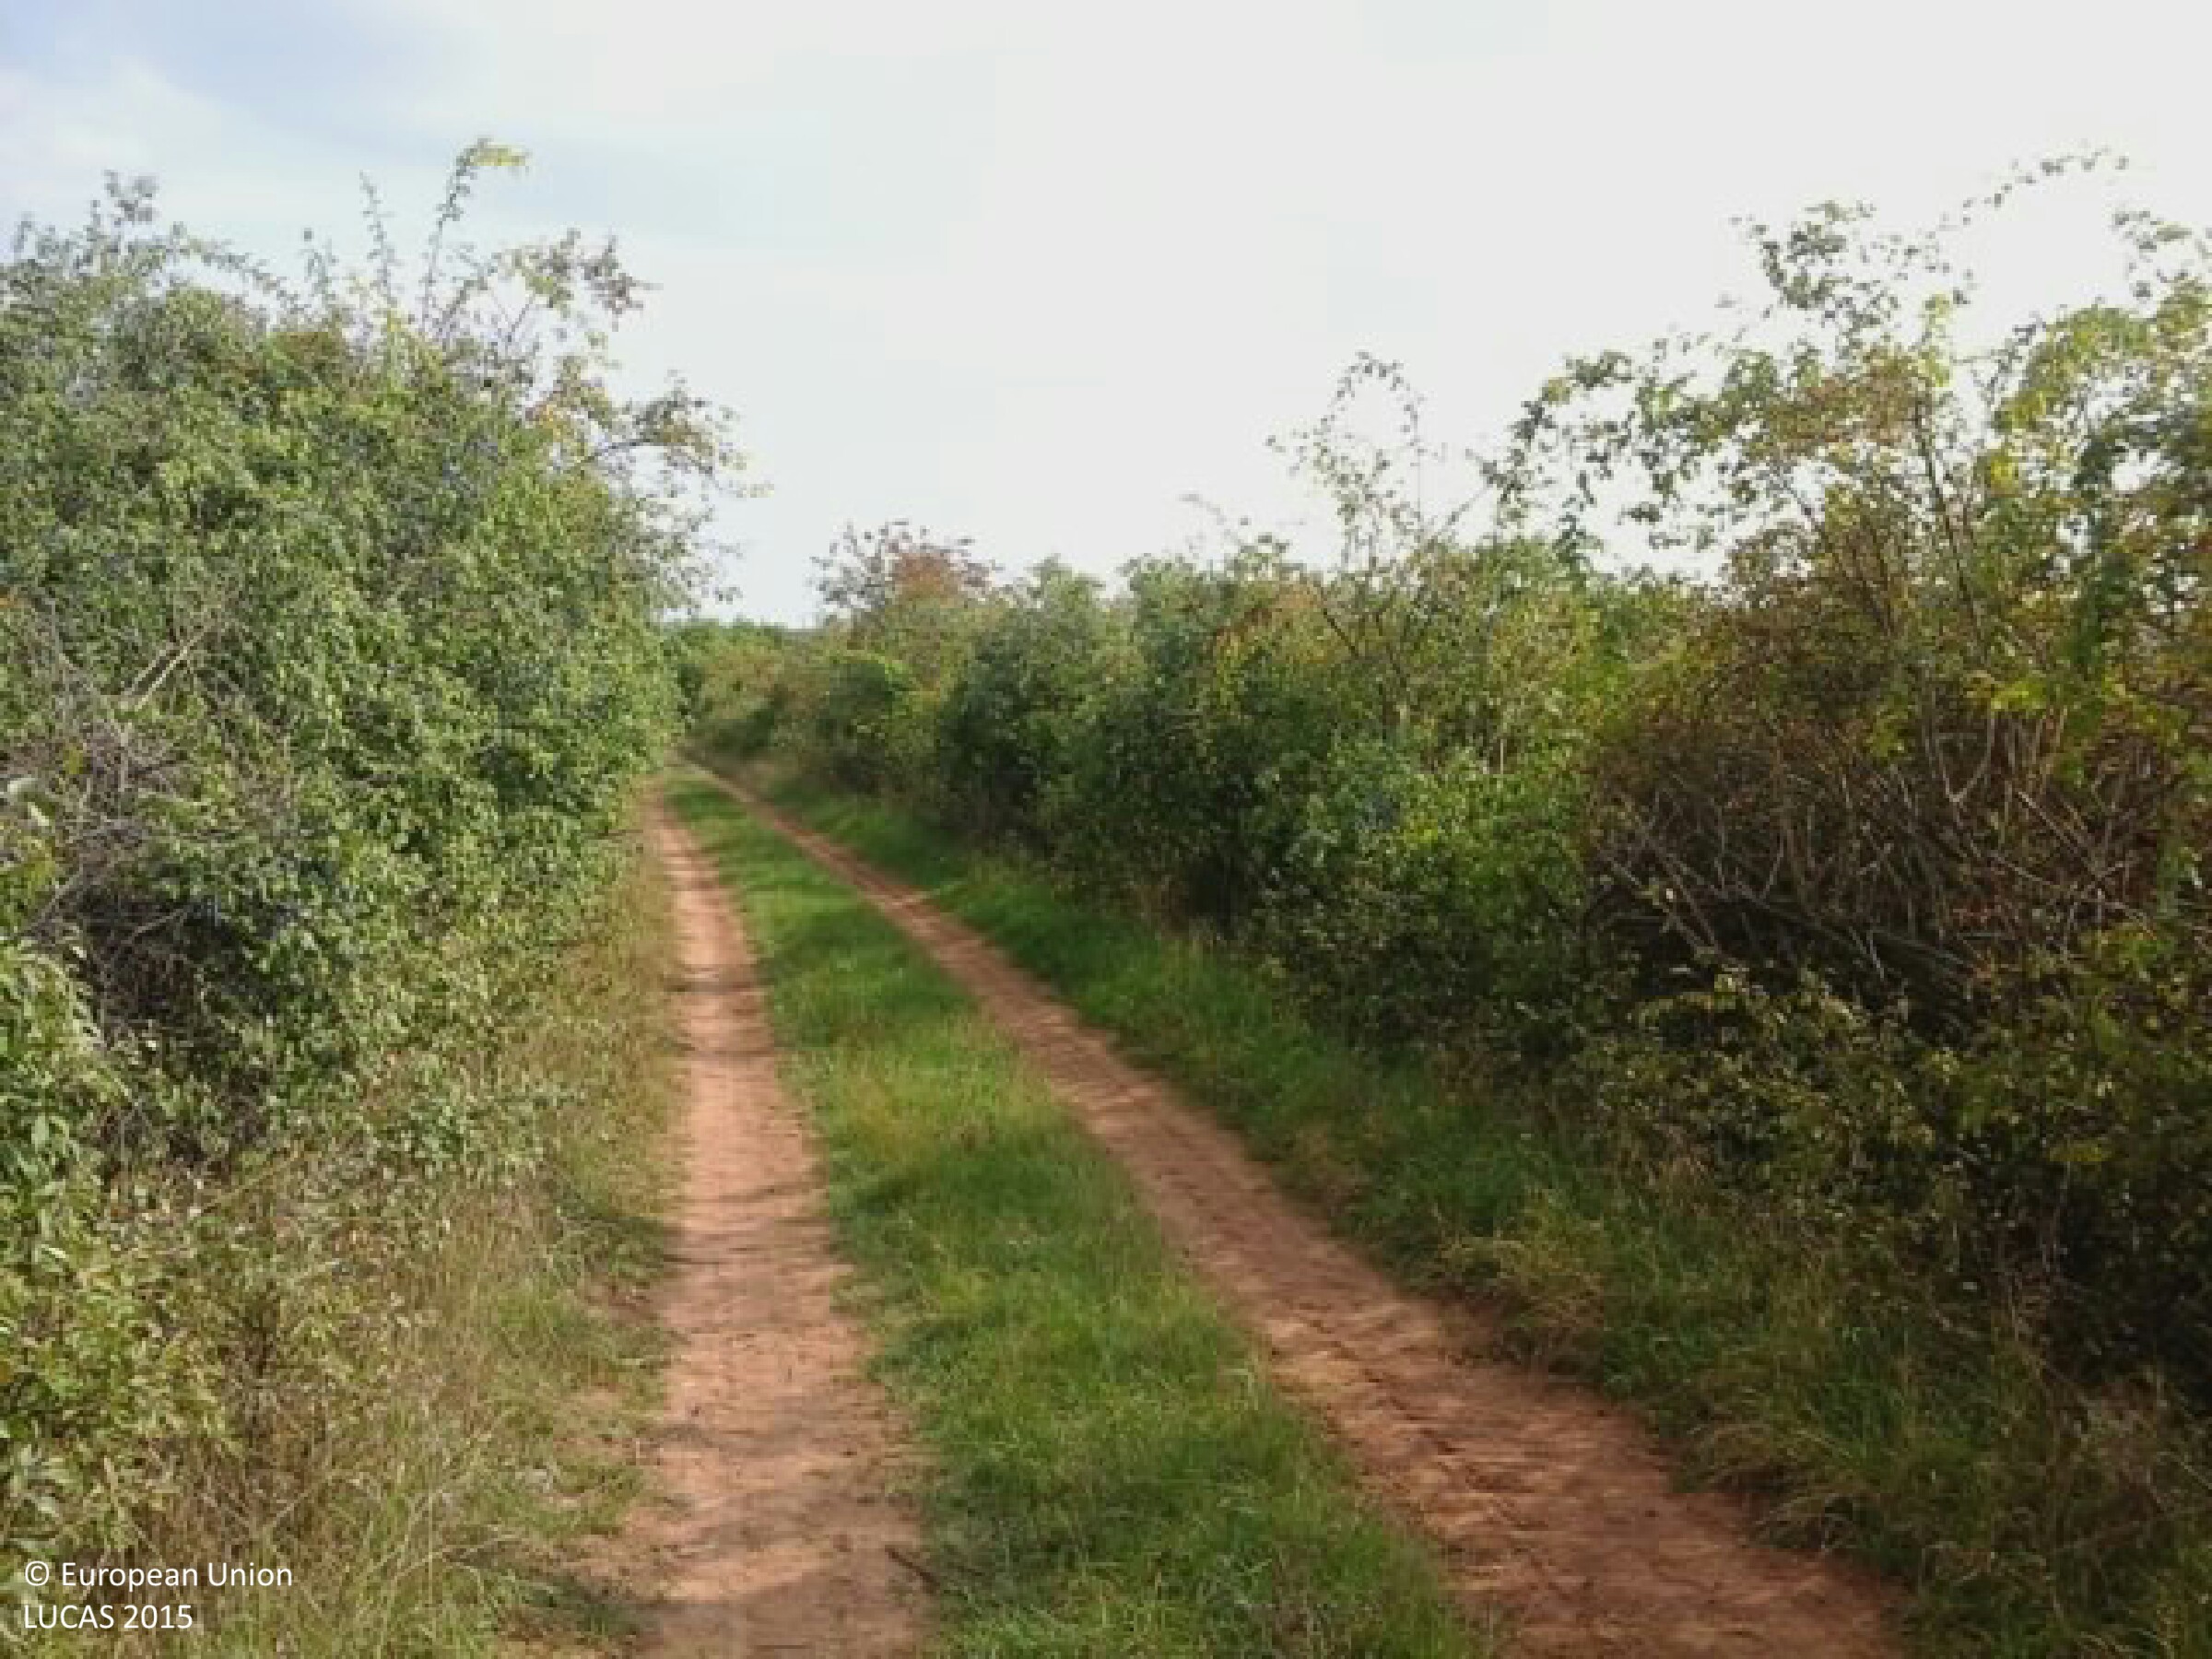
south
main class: Shrubland
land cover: Shrubland without tree cover
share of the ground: > 75 %
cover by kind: herbaceous plants 85 %, shrubs 15 %
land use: Agriculture (excluding fallow land and kitchen gardens)
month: September
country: HU
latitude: 47.7673
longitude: 19.8055
